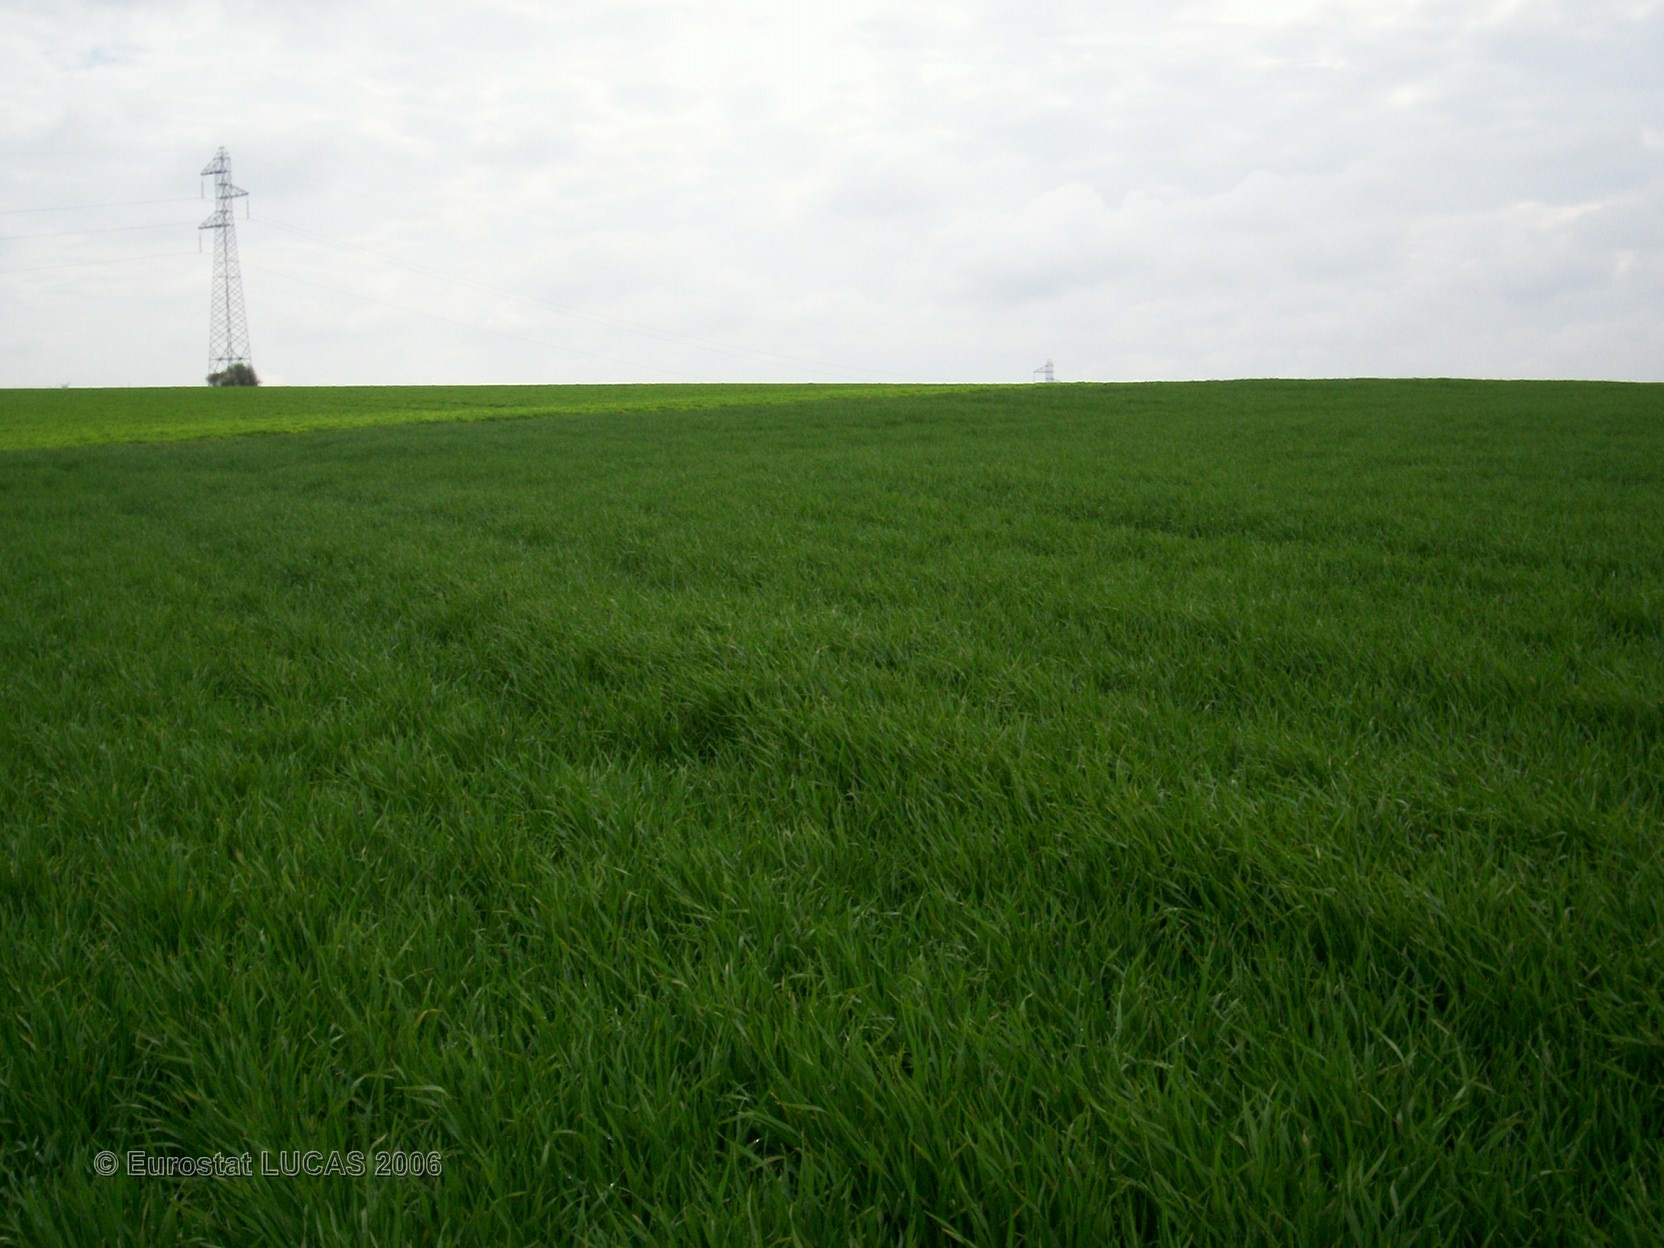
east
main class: Cropland
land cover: Barley
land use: Agriculture (excluding fallow land and kitchen gardens)
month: April
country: FR
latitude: 48.4201
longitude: 3.9828
